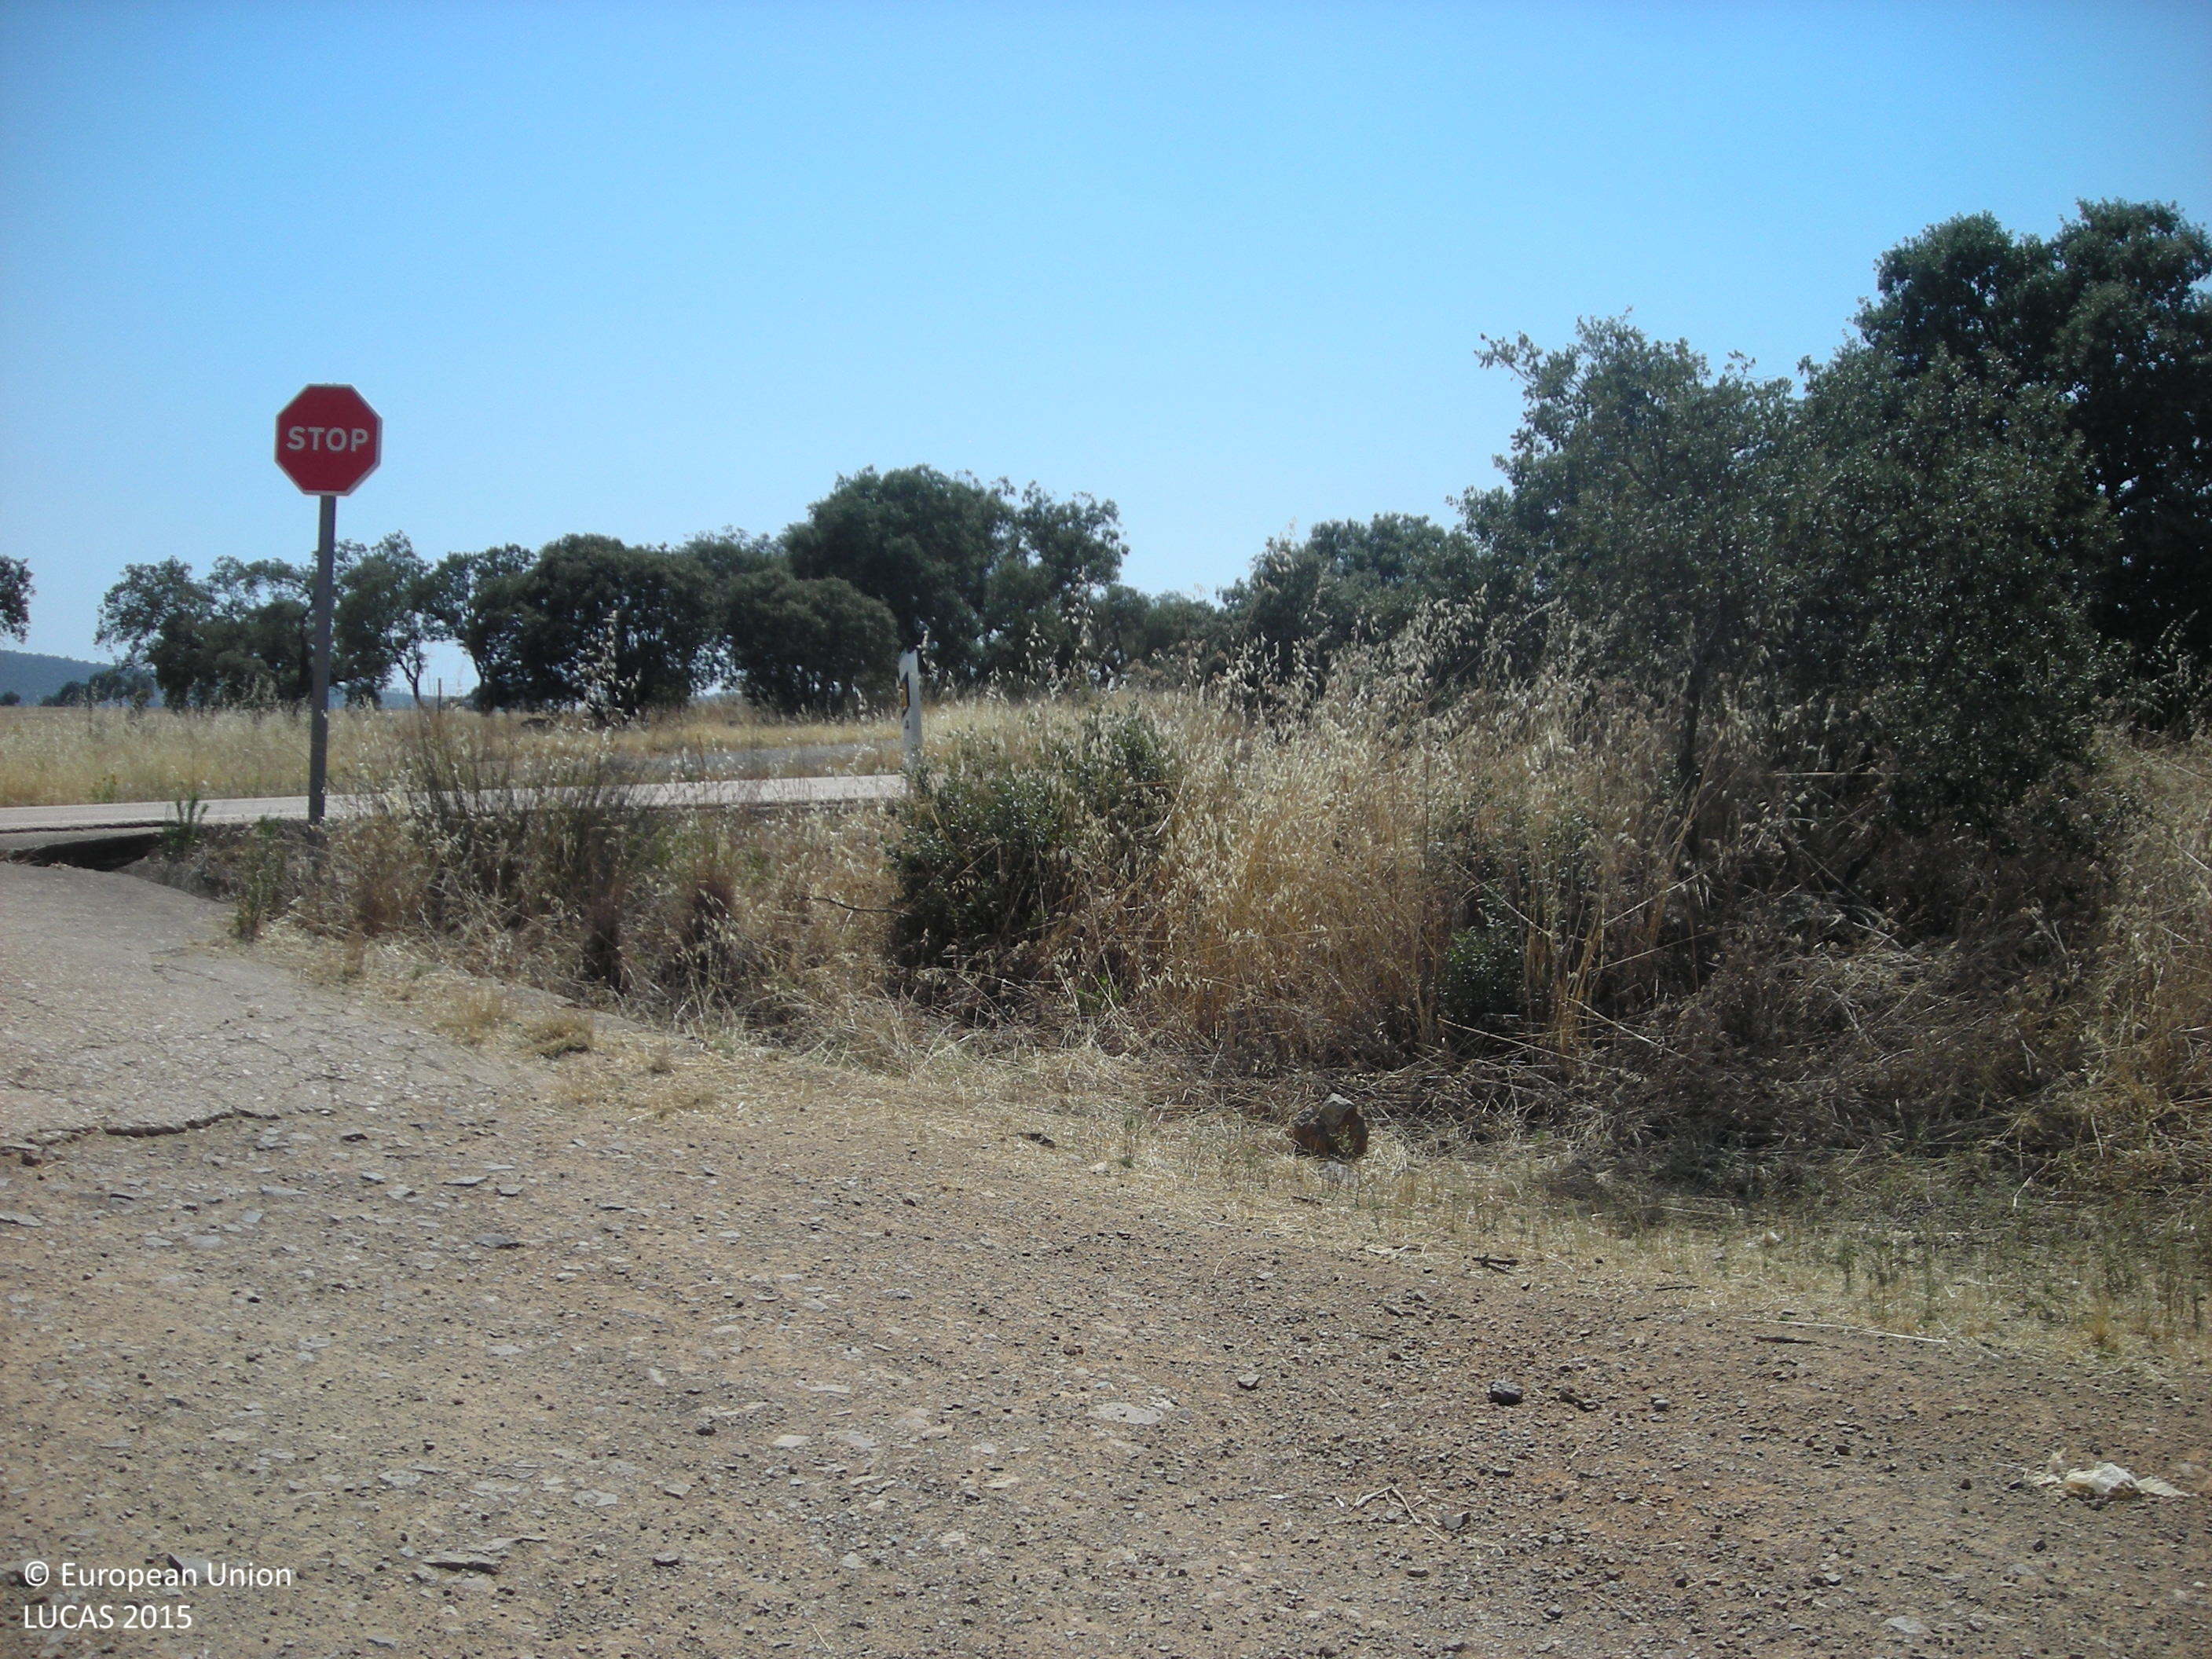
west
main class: Grassland
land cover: Grassland with sparse tree/shrub cover
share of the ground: > 75 %
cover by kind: herbaceous plants 85 %, shrubs 10 %, broadleaved forest trees 5 %
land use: Agriculture (excluding fallow land and kitchen gardens)
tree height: > 5 m
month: June
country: ES
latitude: 38.6362
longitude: -5.8630
